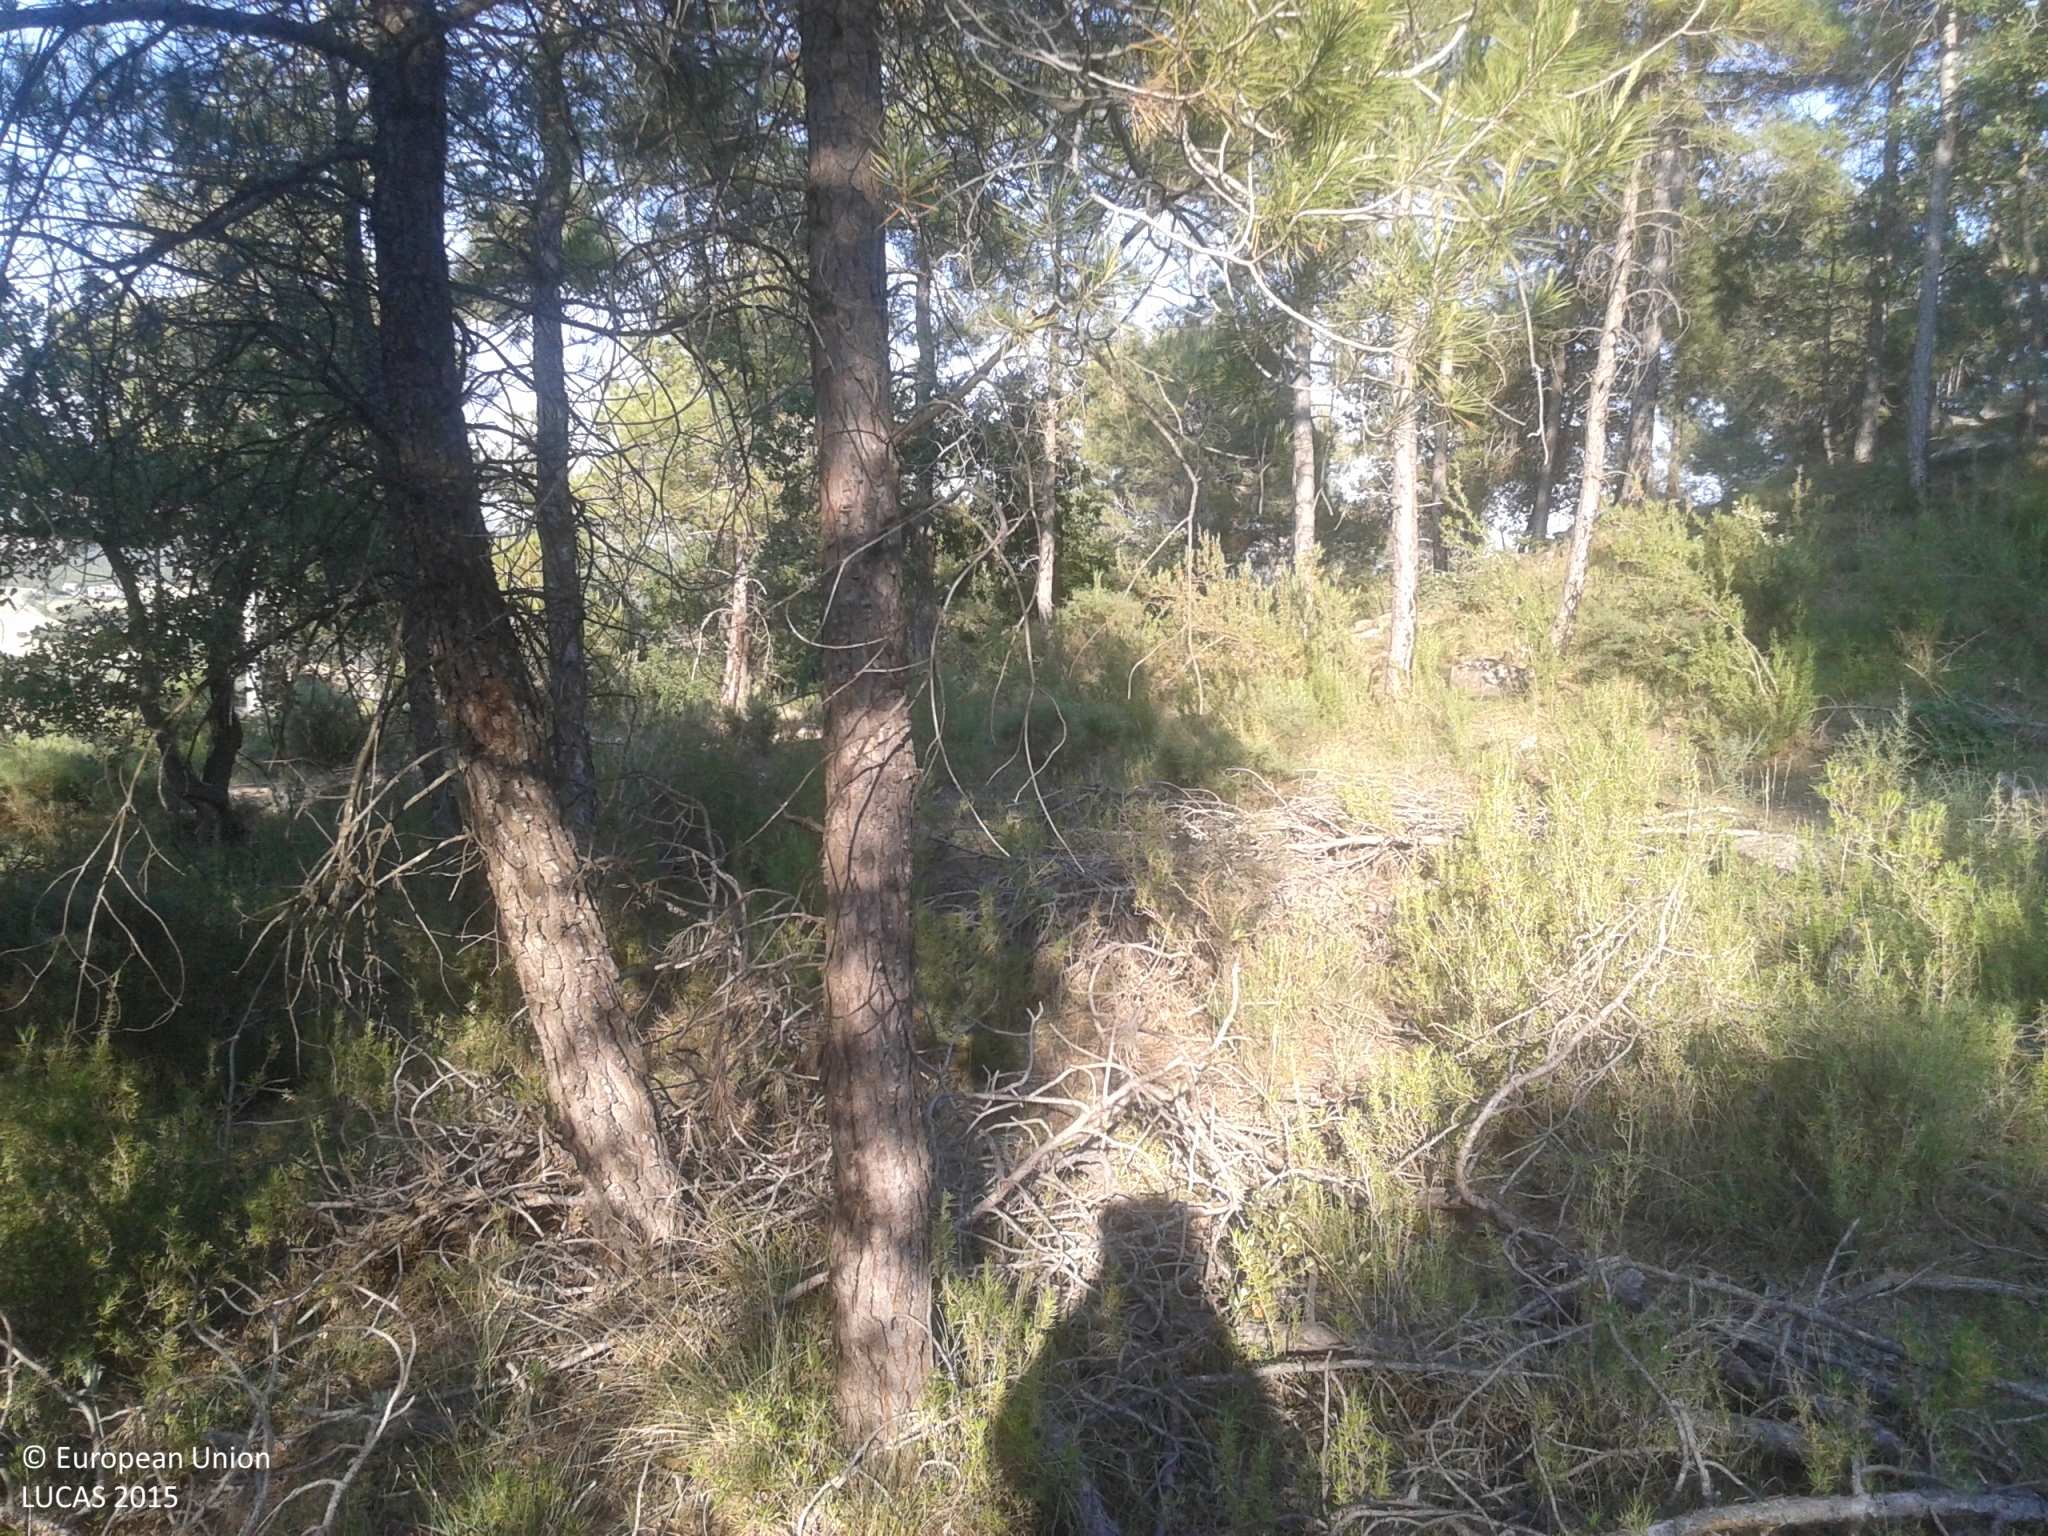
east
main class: Woodland
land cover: Pine dominated mixed woodland
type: coniferous forest of the mediterranean region
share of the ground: > 75 %
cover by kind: coniferous forest trees 60 %, broadleaved forest trees 20 %, shrubs 10 %, herbaceous plants 10 %
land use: Forestry
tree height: > 5 m
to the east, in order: Pine dominated mixed woodland; Tracks; Pine dominated mixed woodland; Tracks; Pine dominated mixed woodland; Tracks; Pine dominated mixed woodland; Grassland without tree/shrub cover; Barley
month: June
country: ES
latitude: 41.9620
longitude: 1.6275
